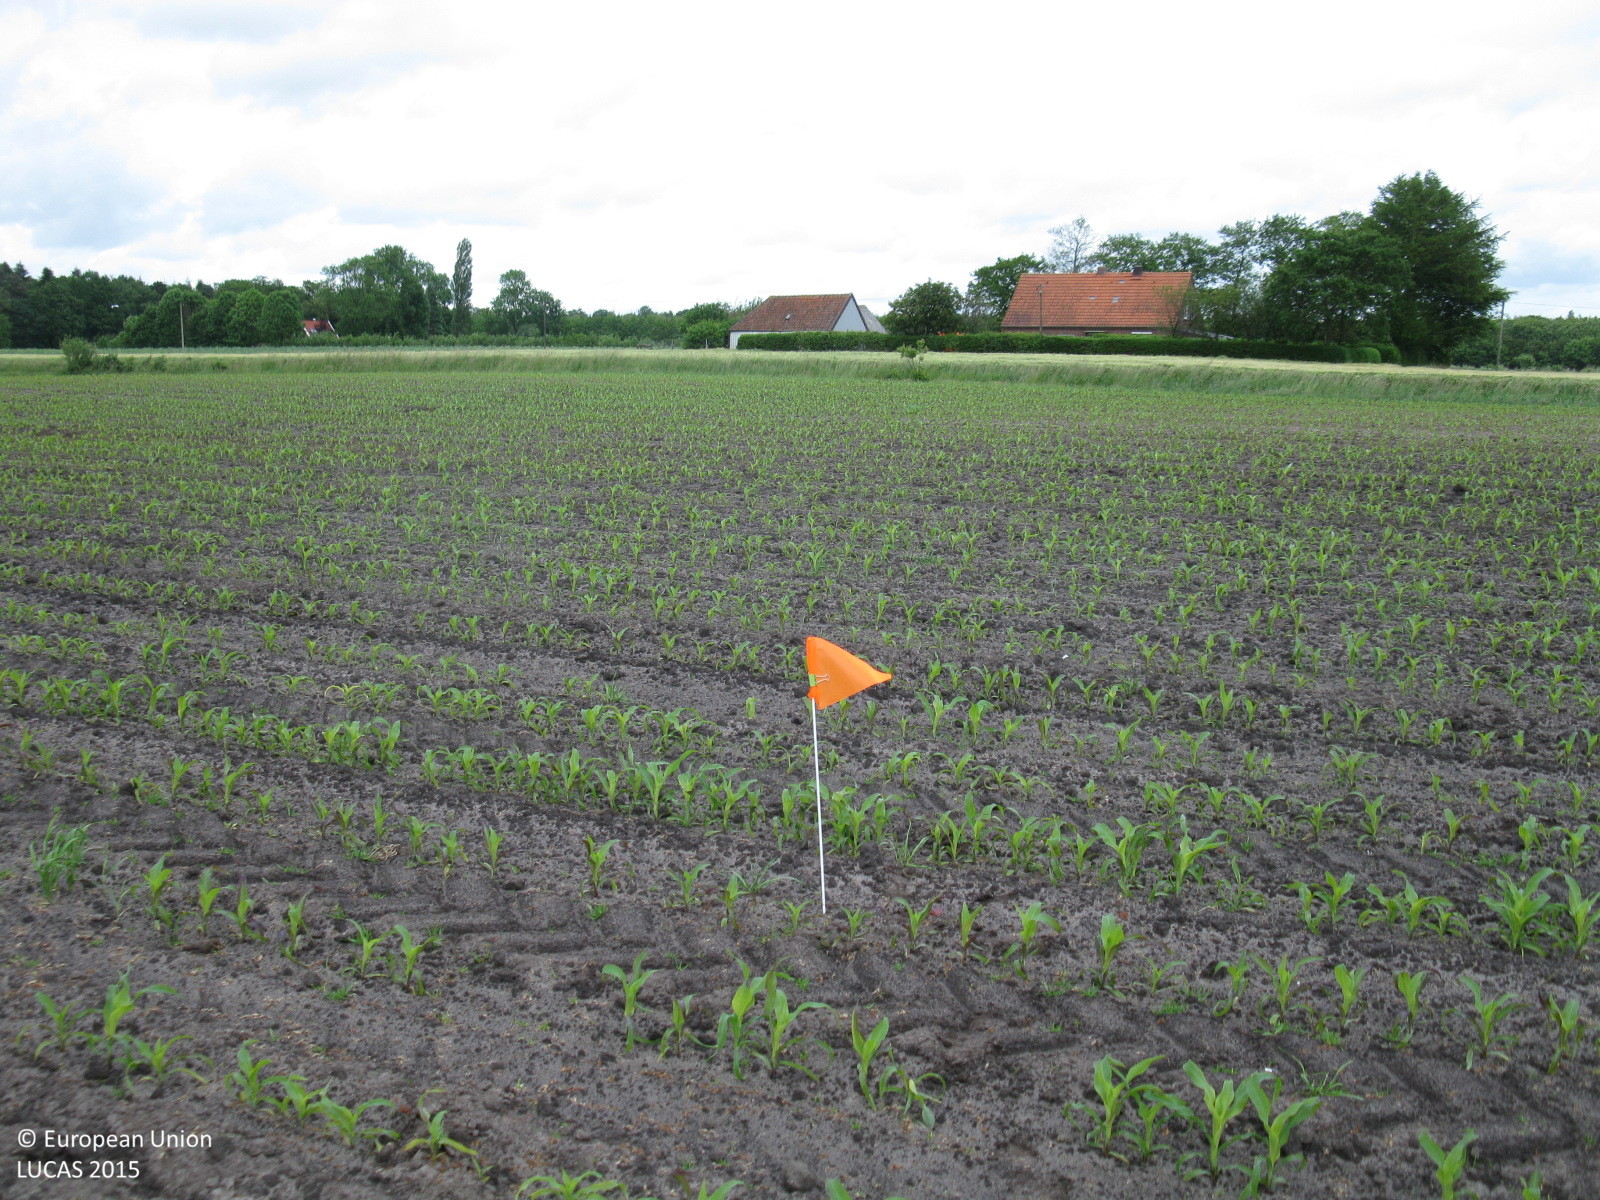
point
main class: Cropland
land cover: Maize
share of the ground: 10 - 25 %
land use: Agriculture (excluding fallow land and kitchen gardens)
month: June
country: DE
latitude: 53.5703
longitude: 7.3279
